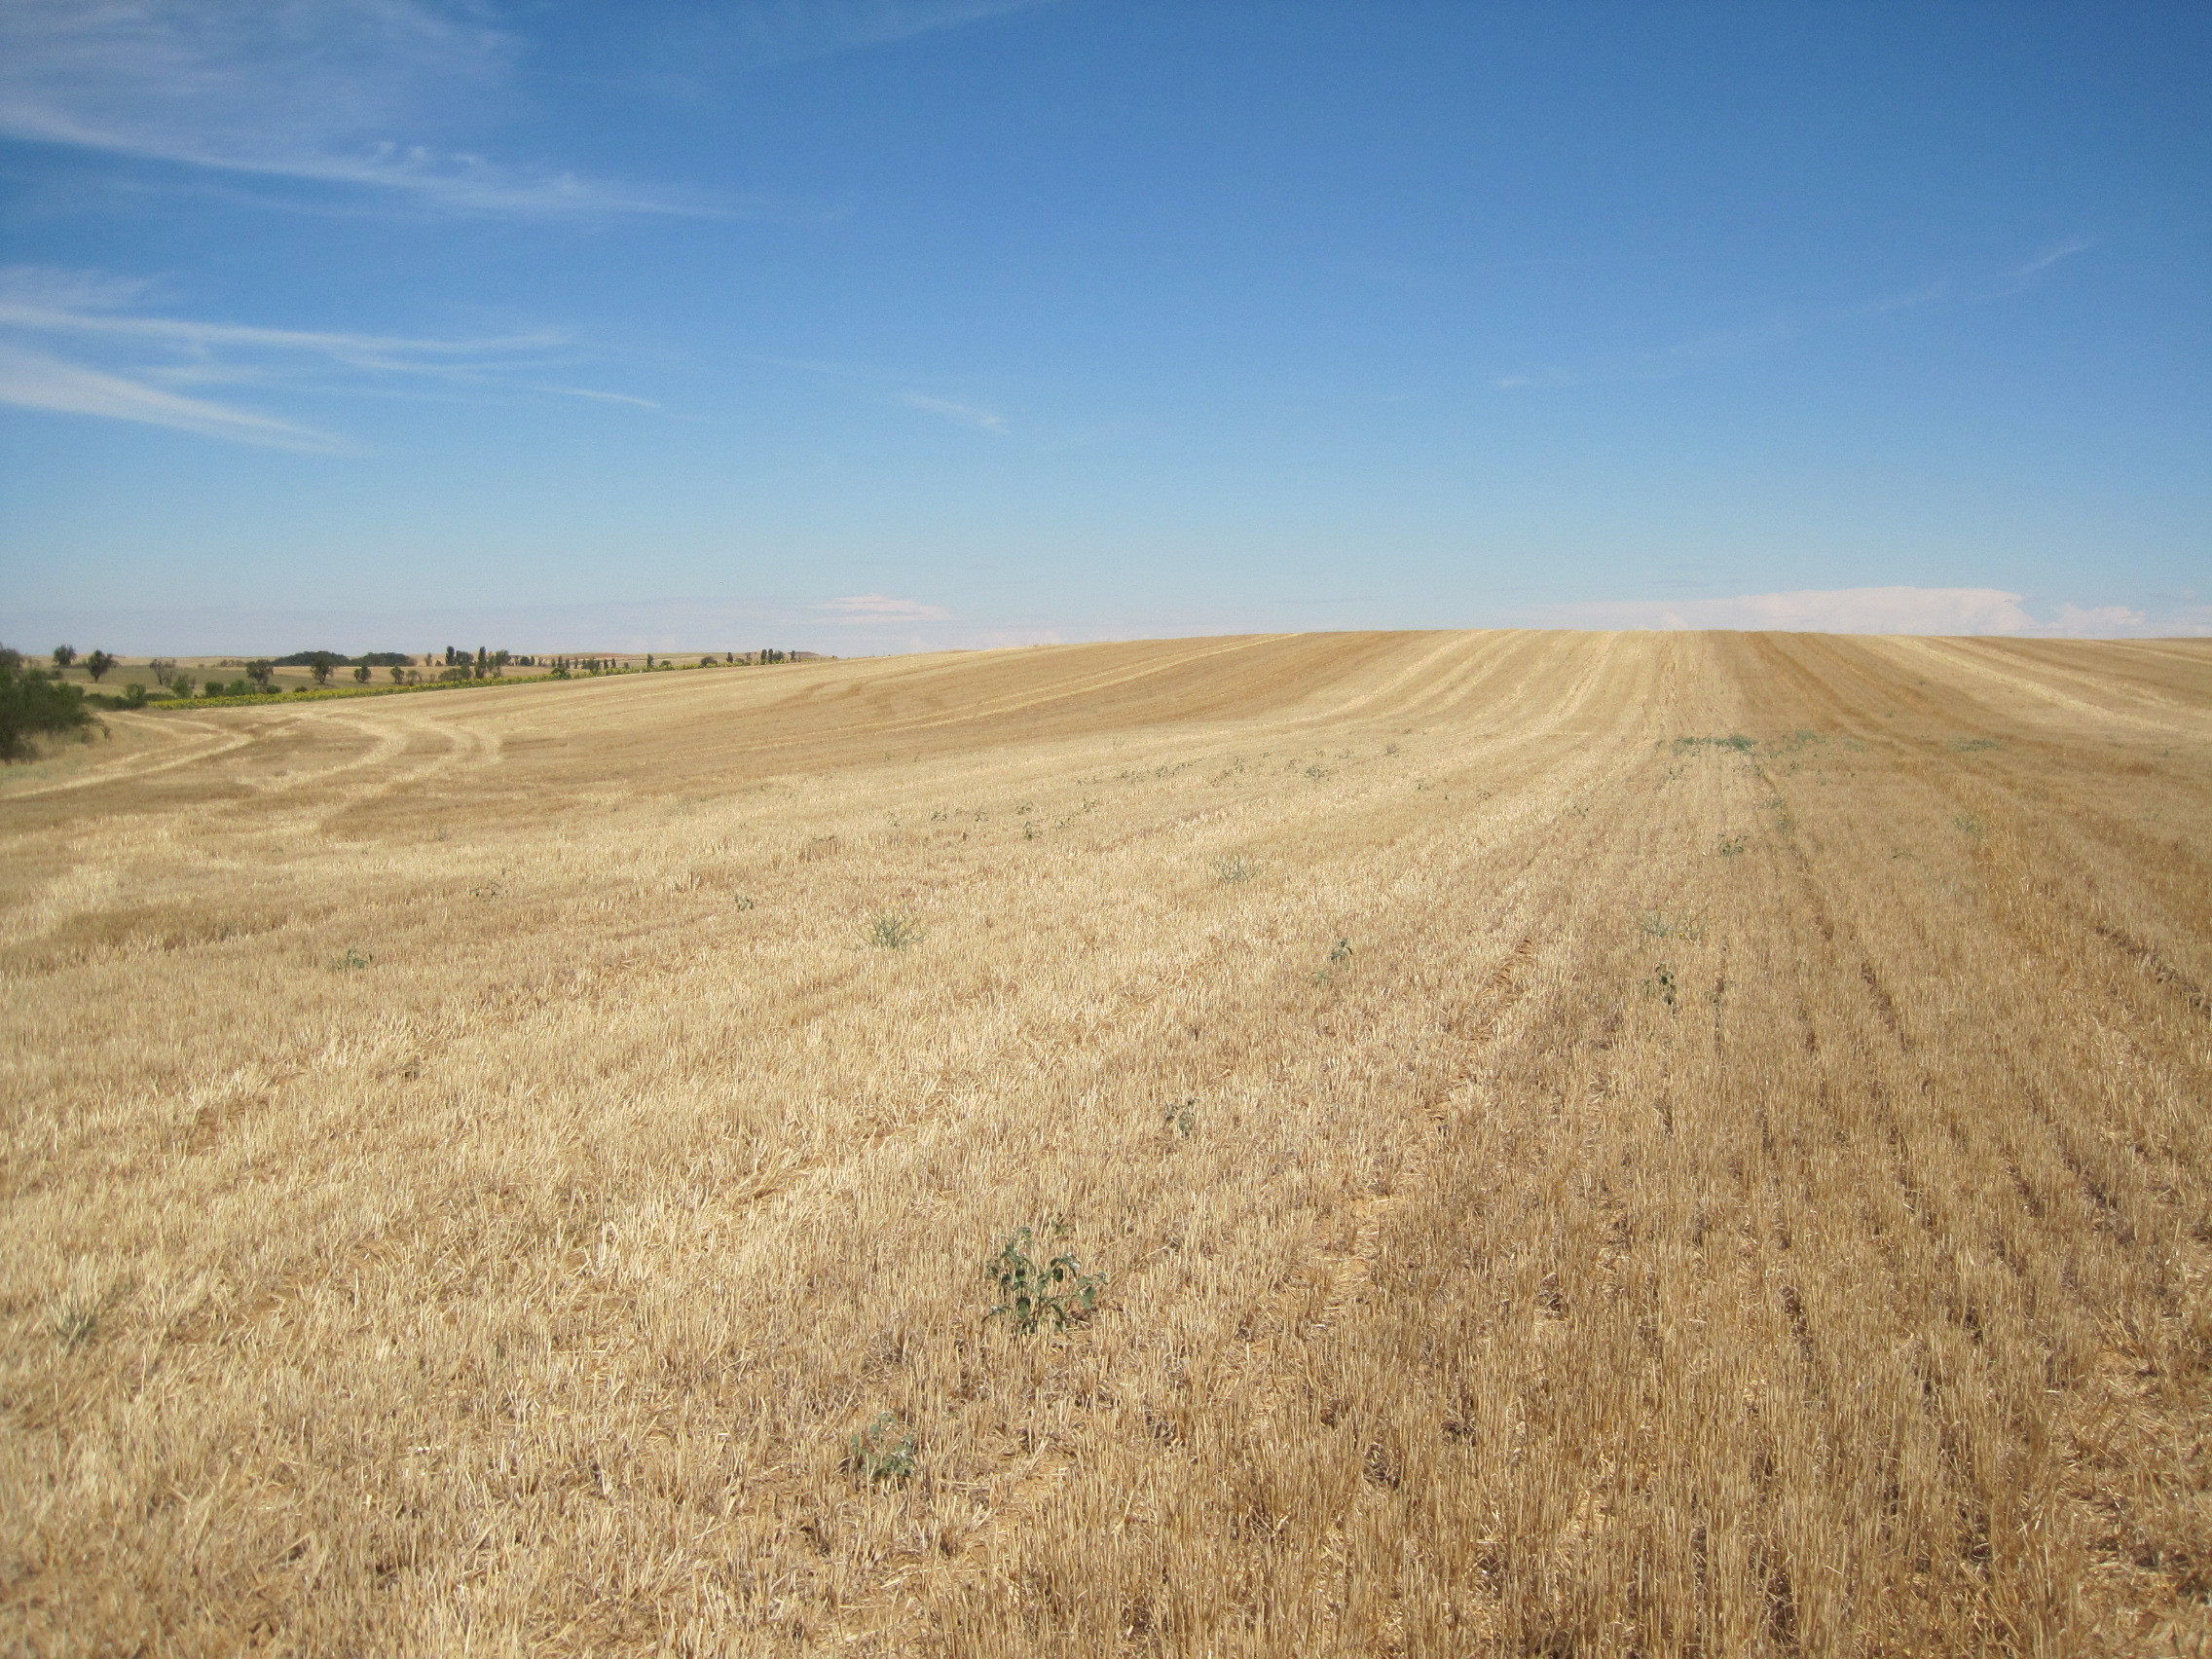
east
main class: Cropland
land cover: Barley
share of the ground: < 10 %
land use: Agriculture (excluding fallow land and kitchen gardens)
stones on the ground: < 10 %
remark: Harvested field
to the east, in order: Barley; Grass margins; Sunflower
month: July
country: ES
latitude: 41.9932
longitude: -5.2079
